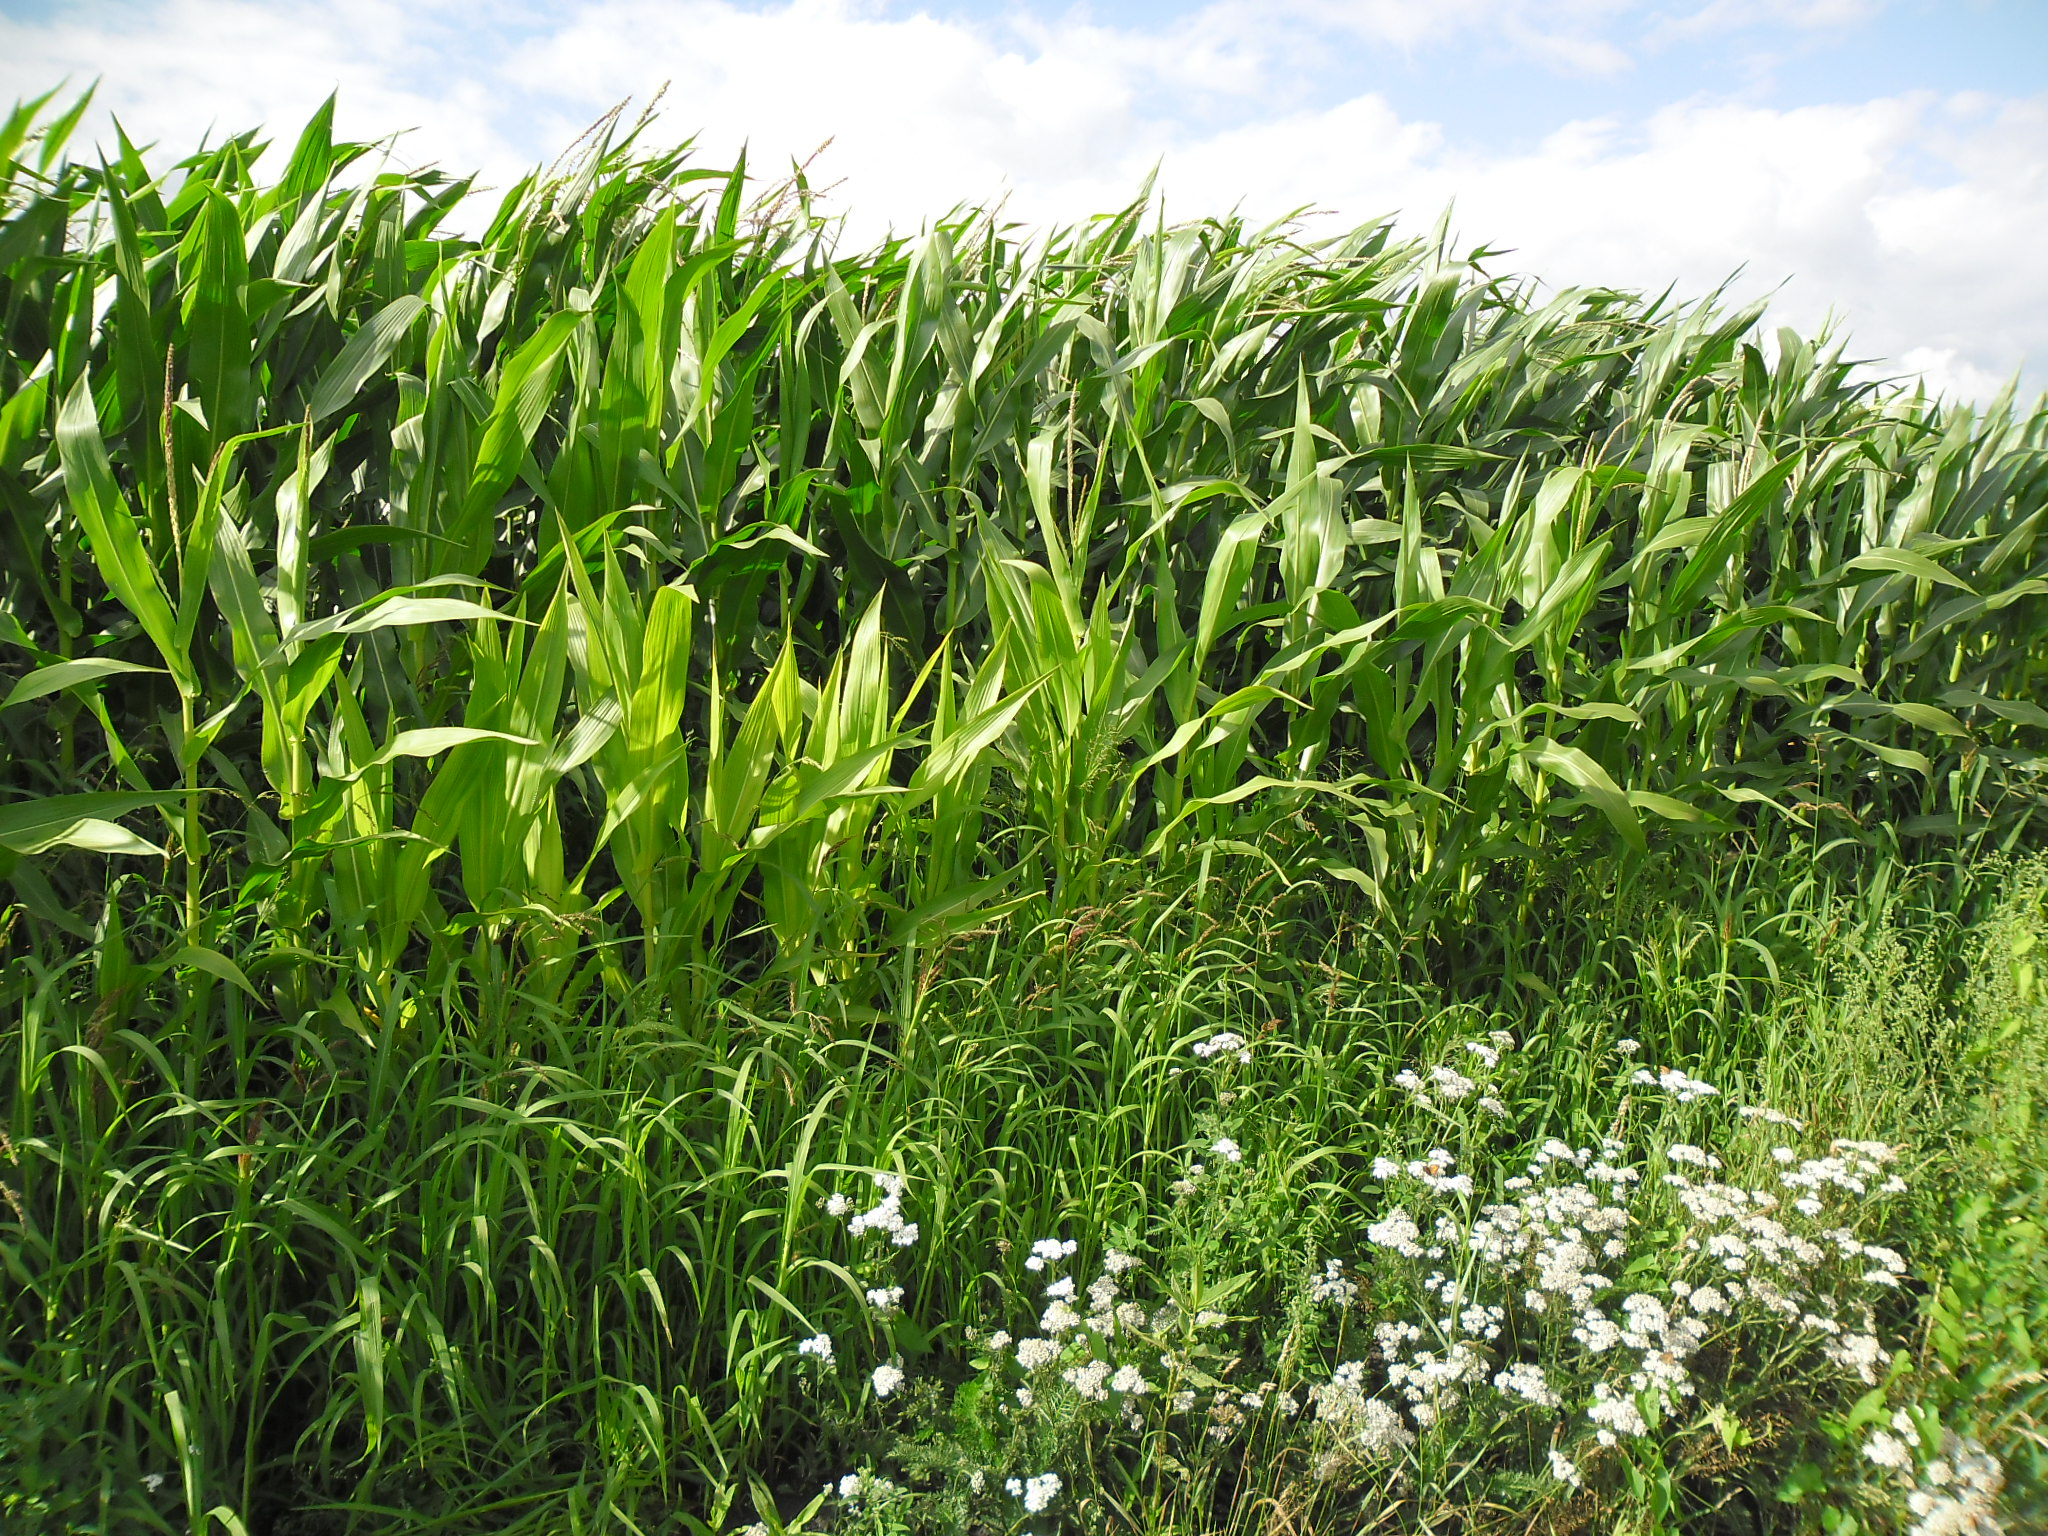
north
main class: Cropland
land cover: Maize
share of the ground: > 75 %
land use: Agriculture (excluding fallow land and kitchen gardens)
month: July
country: NL
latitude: 52.6416
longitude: 6.2311
